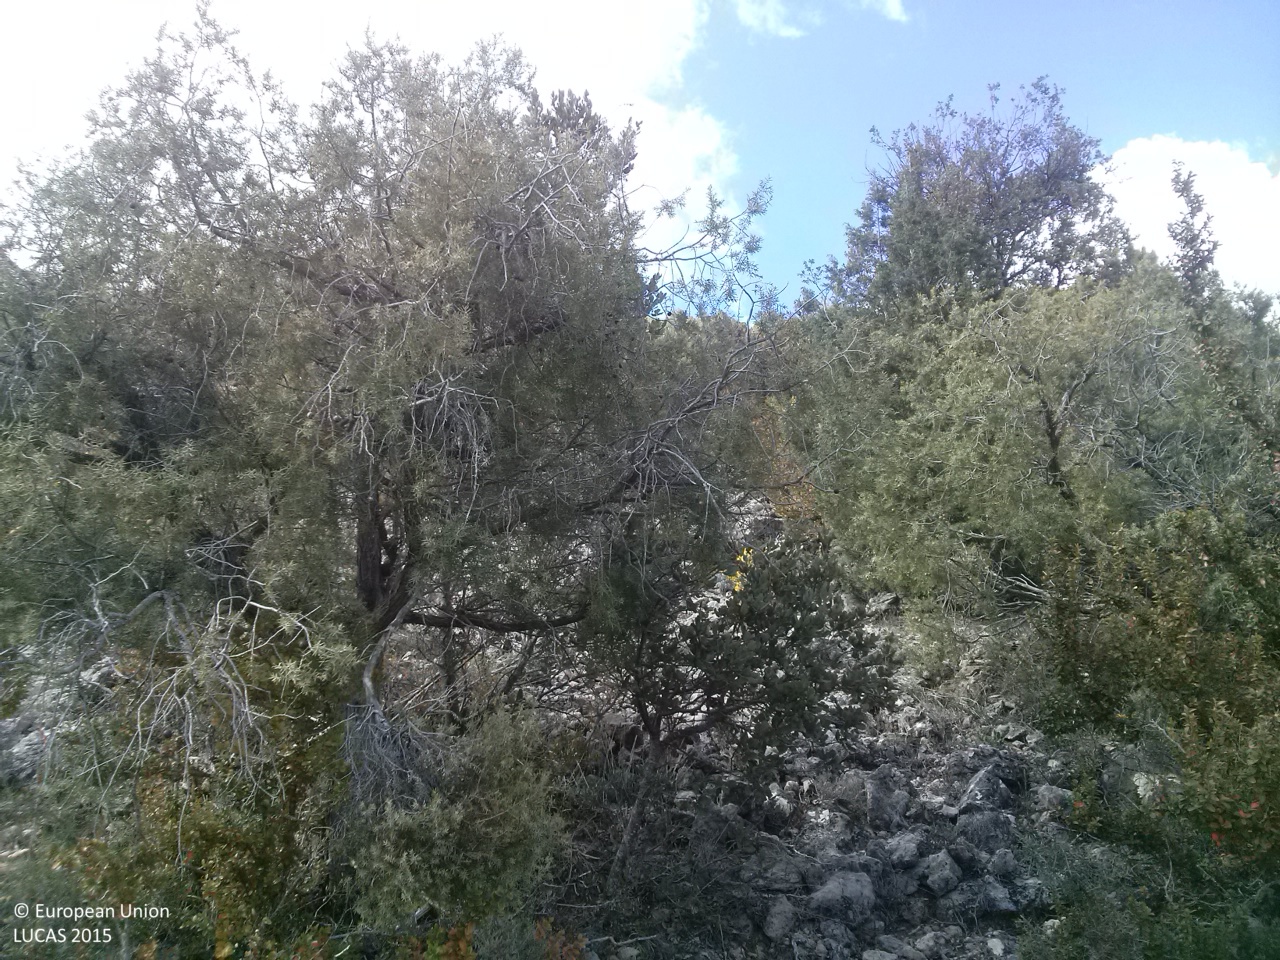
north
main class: Shrubland
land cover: Shrubland with sparse tree cover
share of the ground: 25 - 50 %
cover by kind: consolidated bare surface 50 %, shrubs 35 %, herbaceous plants 10 %, coniferous forest trees 5 %
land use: Agriculture (excluding fallow land and kitchen gardens)
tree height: < 5 m
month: April
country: ES
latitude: 40.1499
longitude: -1.6932
